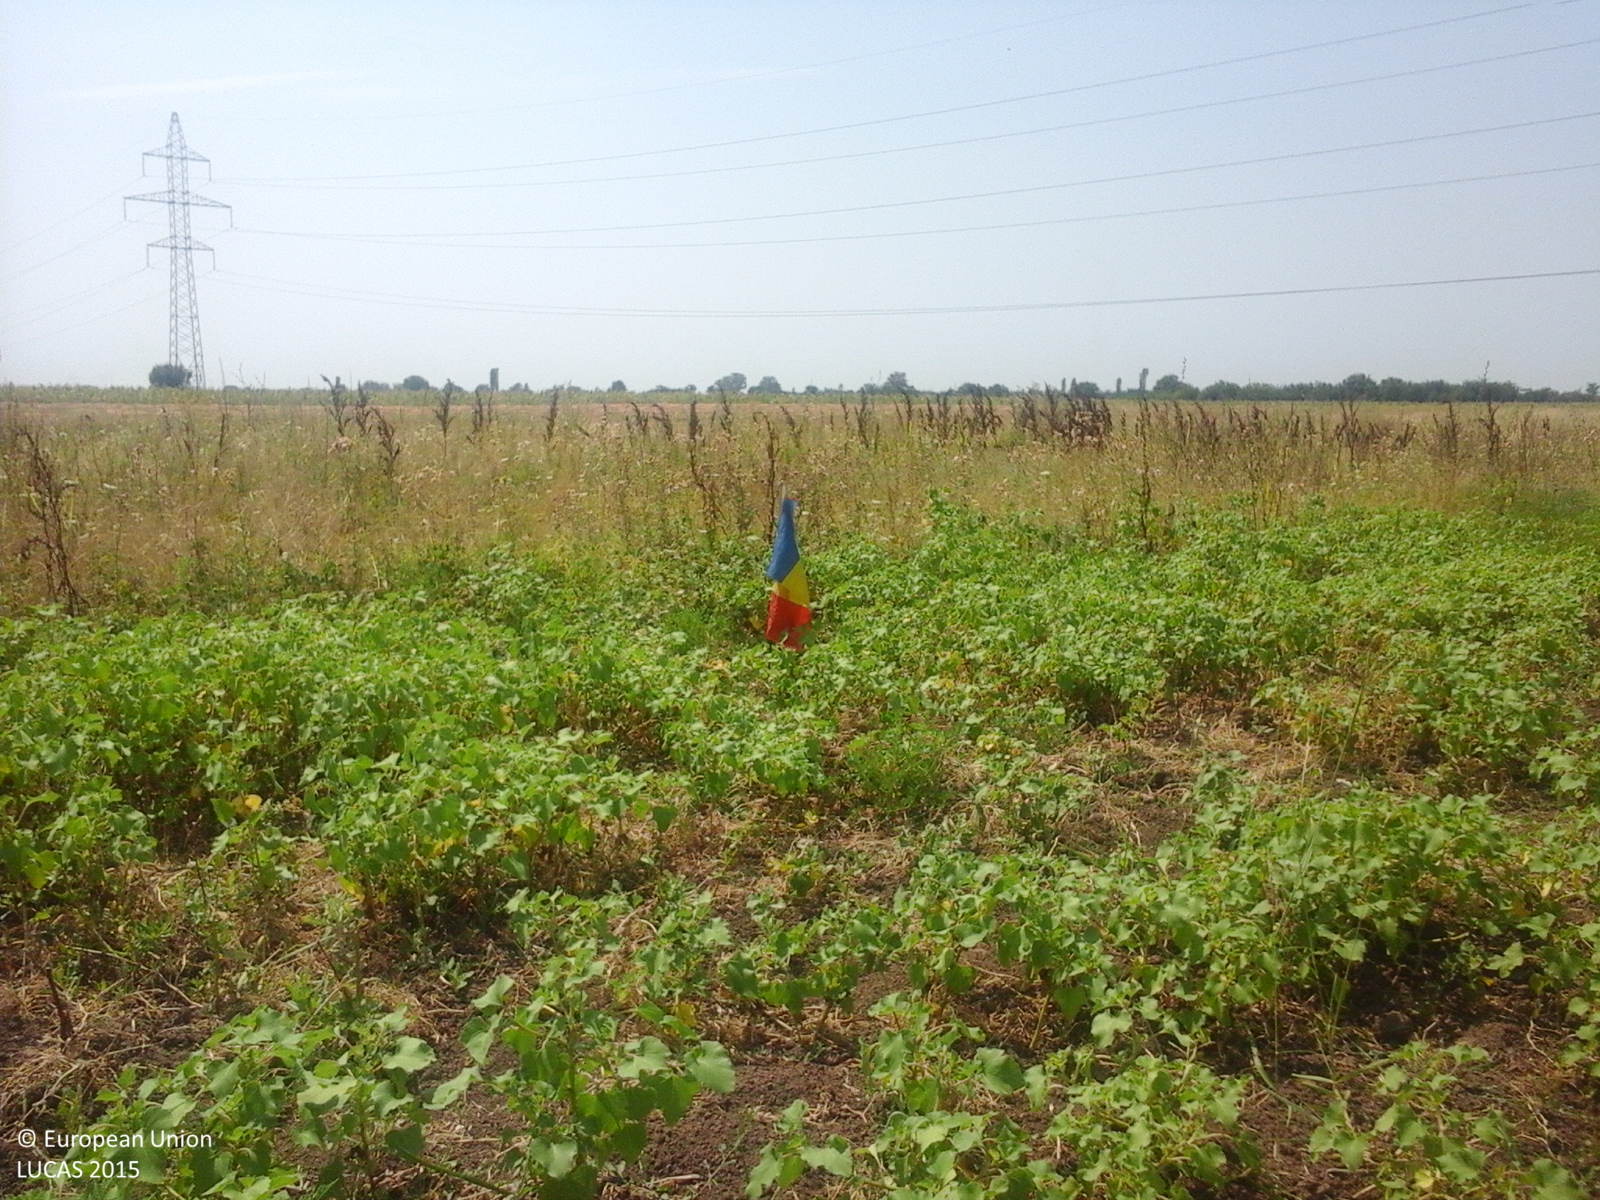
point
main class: Grassland
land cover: Spontaneously vegetated surfaces
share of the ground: > 75 %
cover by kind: herbaceous plants 100 %
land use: Fallow land
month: August
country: RO
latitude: 44.2672
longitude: 22.9332
